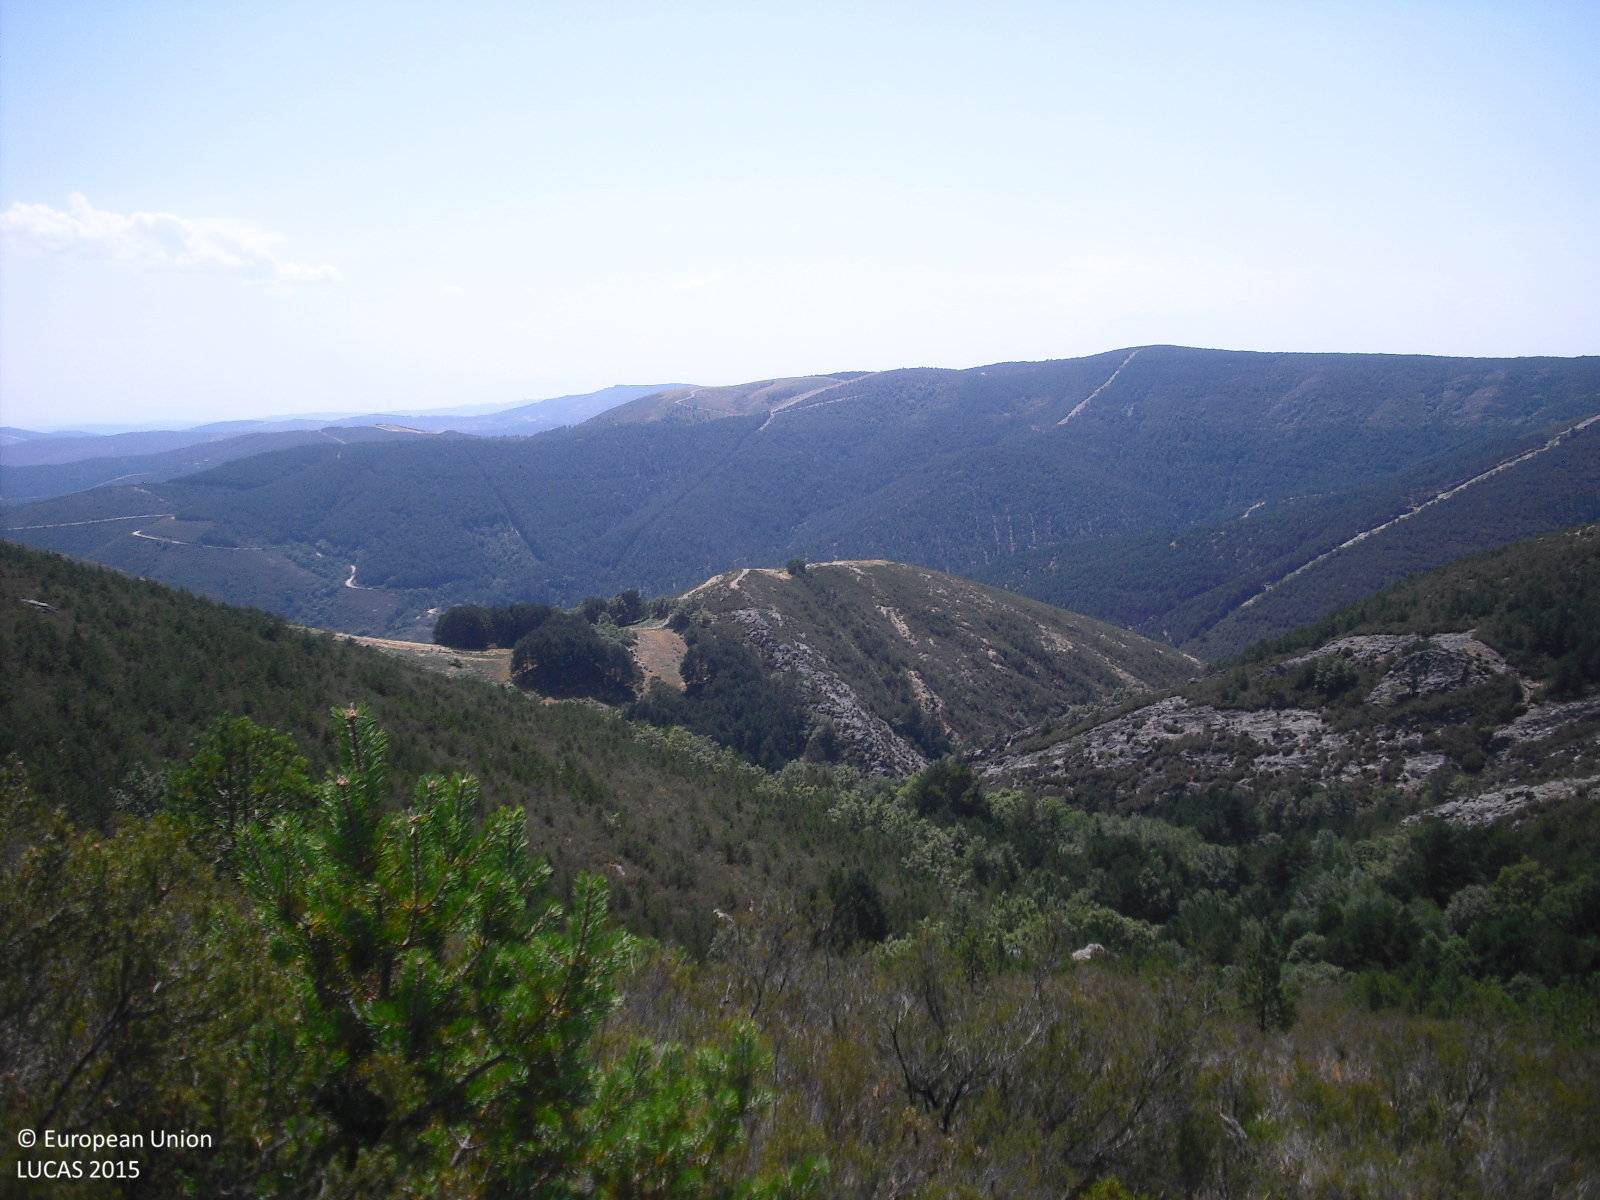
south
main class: Shrubland
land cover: Shrubland with sparse tree cover
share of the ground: > 75 %
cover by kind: shrubs 95 %, coniferous forest trees 5 %
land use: Forestry
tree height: < 5 m
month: August
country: ES
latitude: 42.1384
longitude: -7.3499
